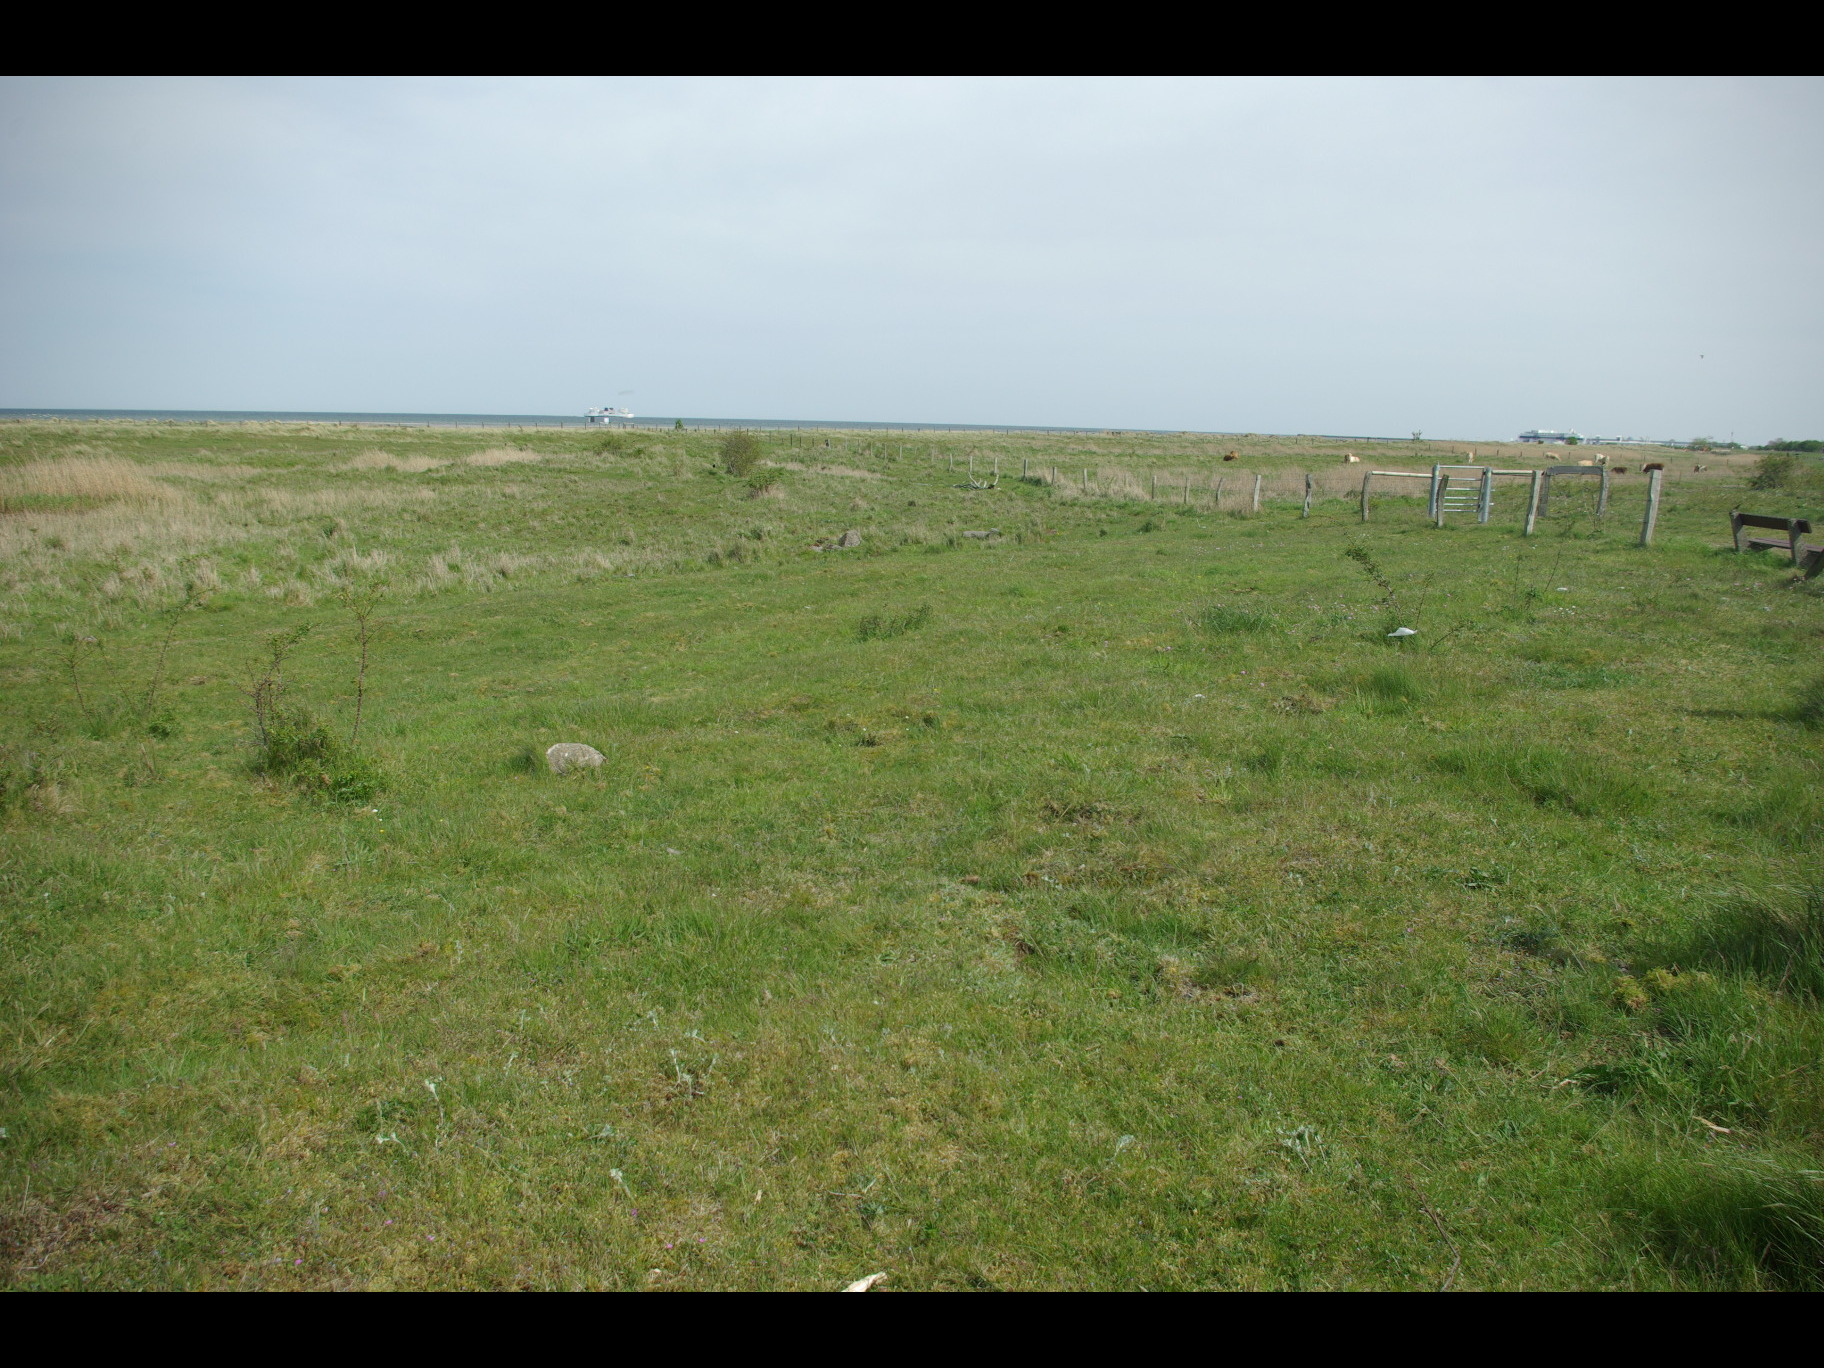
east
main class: Grassland
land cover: Grassland without tree/shrub cover
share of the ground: > 75 %
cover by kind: herbaceous plants 80 %, lichens and mosses 10 %, shrubs 5 %, unconsolidated bare surface 5 %
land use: Protection infrastructures
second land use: Agriculture (excluding fallow land and kitchen gardens)
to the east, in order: Grassland without tree/shrub cover; Fences; Tracks; Grassland without tree/shrub cover
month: May
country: DE
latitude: 54.5105
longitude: 11.1885
